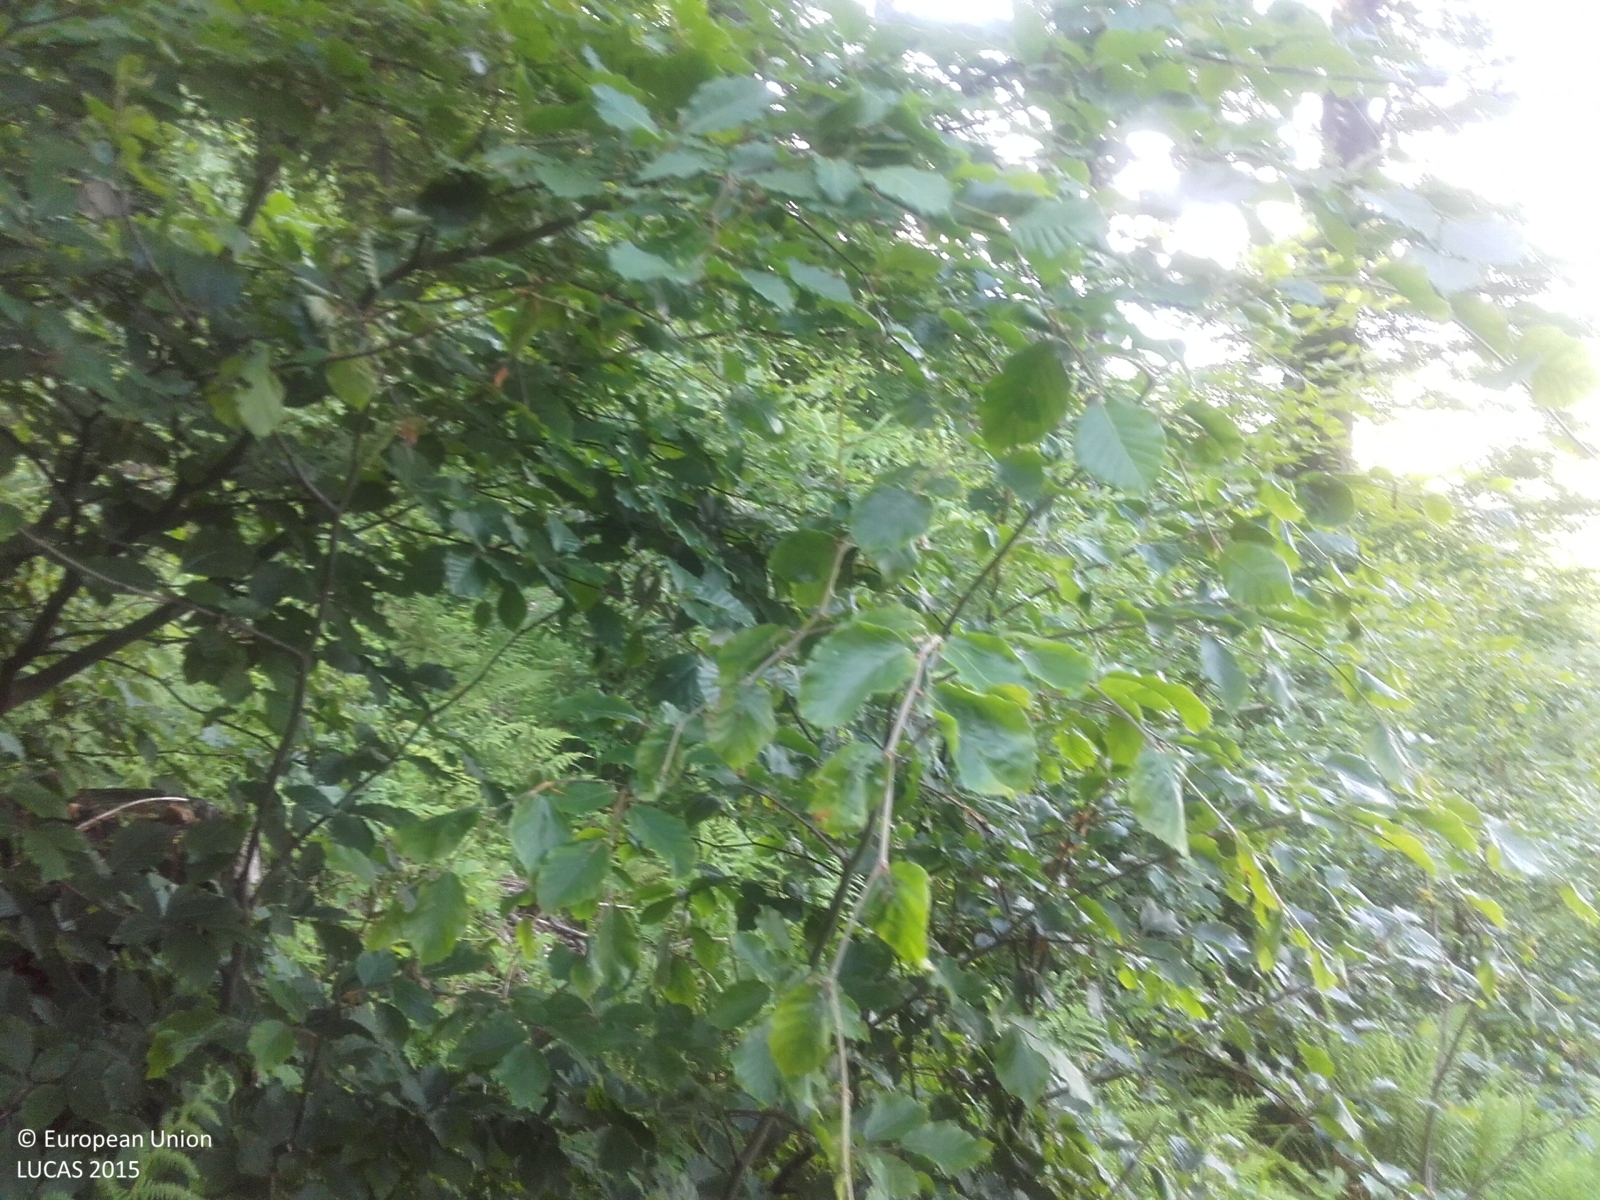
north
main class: Woodland
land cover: Broadleaved woodland
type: mesophytic deciduous forest
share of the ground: > 75 %
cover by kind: broadleaved forest trees 90 %, herbaceous plants 10 %
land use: Forestry
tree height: > 5 m
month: June
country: CZ
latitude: 49.6276
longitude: 18.7841
